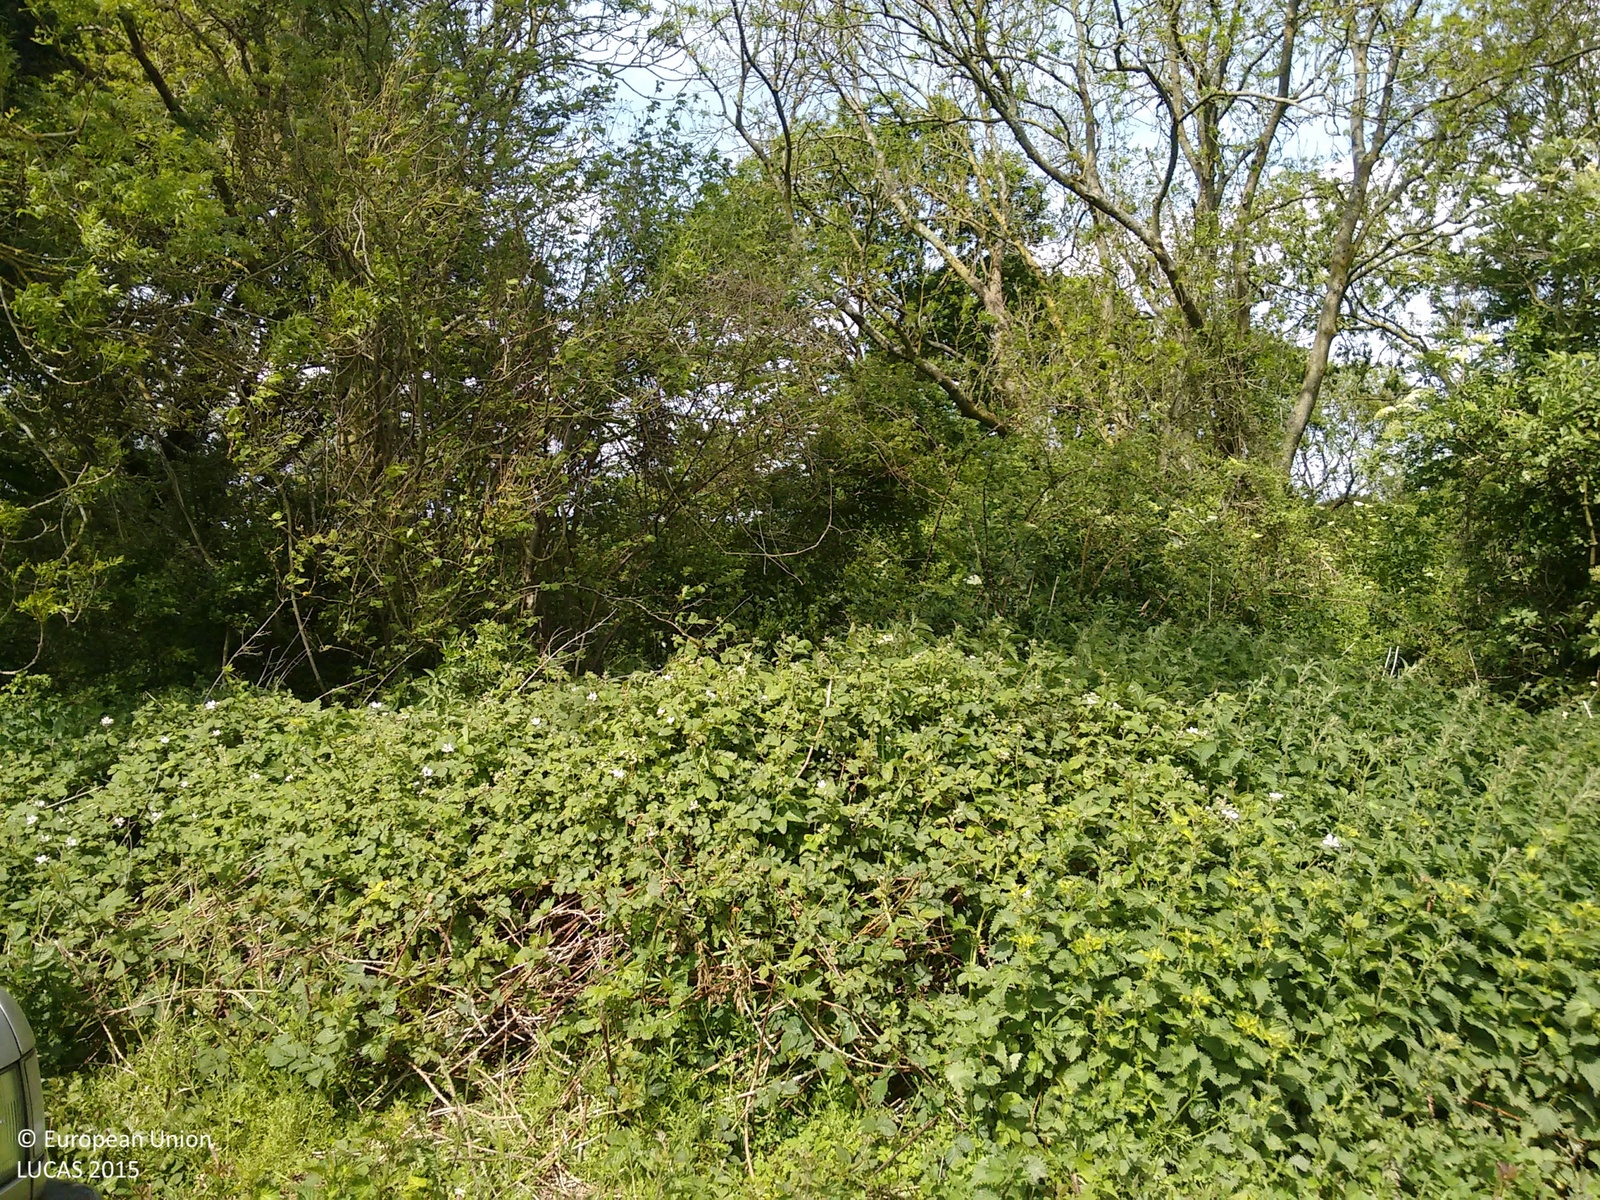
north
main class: Cropland
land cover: Barley
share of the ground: > 75 %
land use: Agriculture (excluding fallow land and kitchen gardens)
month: May
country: GB
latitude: 50.8209
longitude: -2.1692
